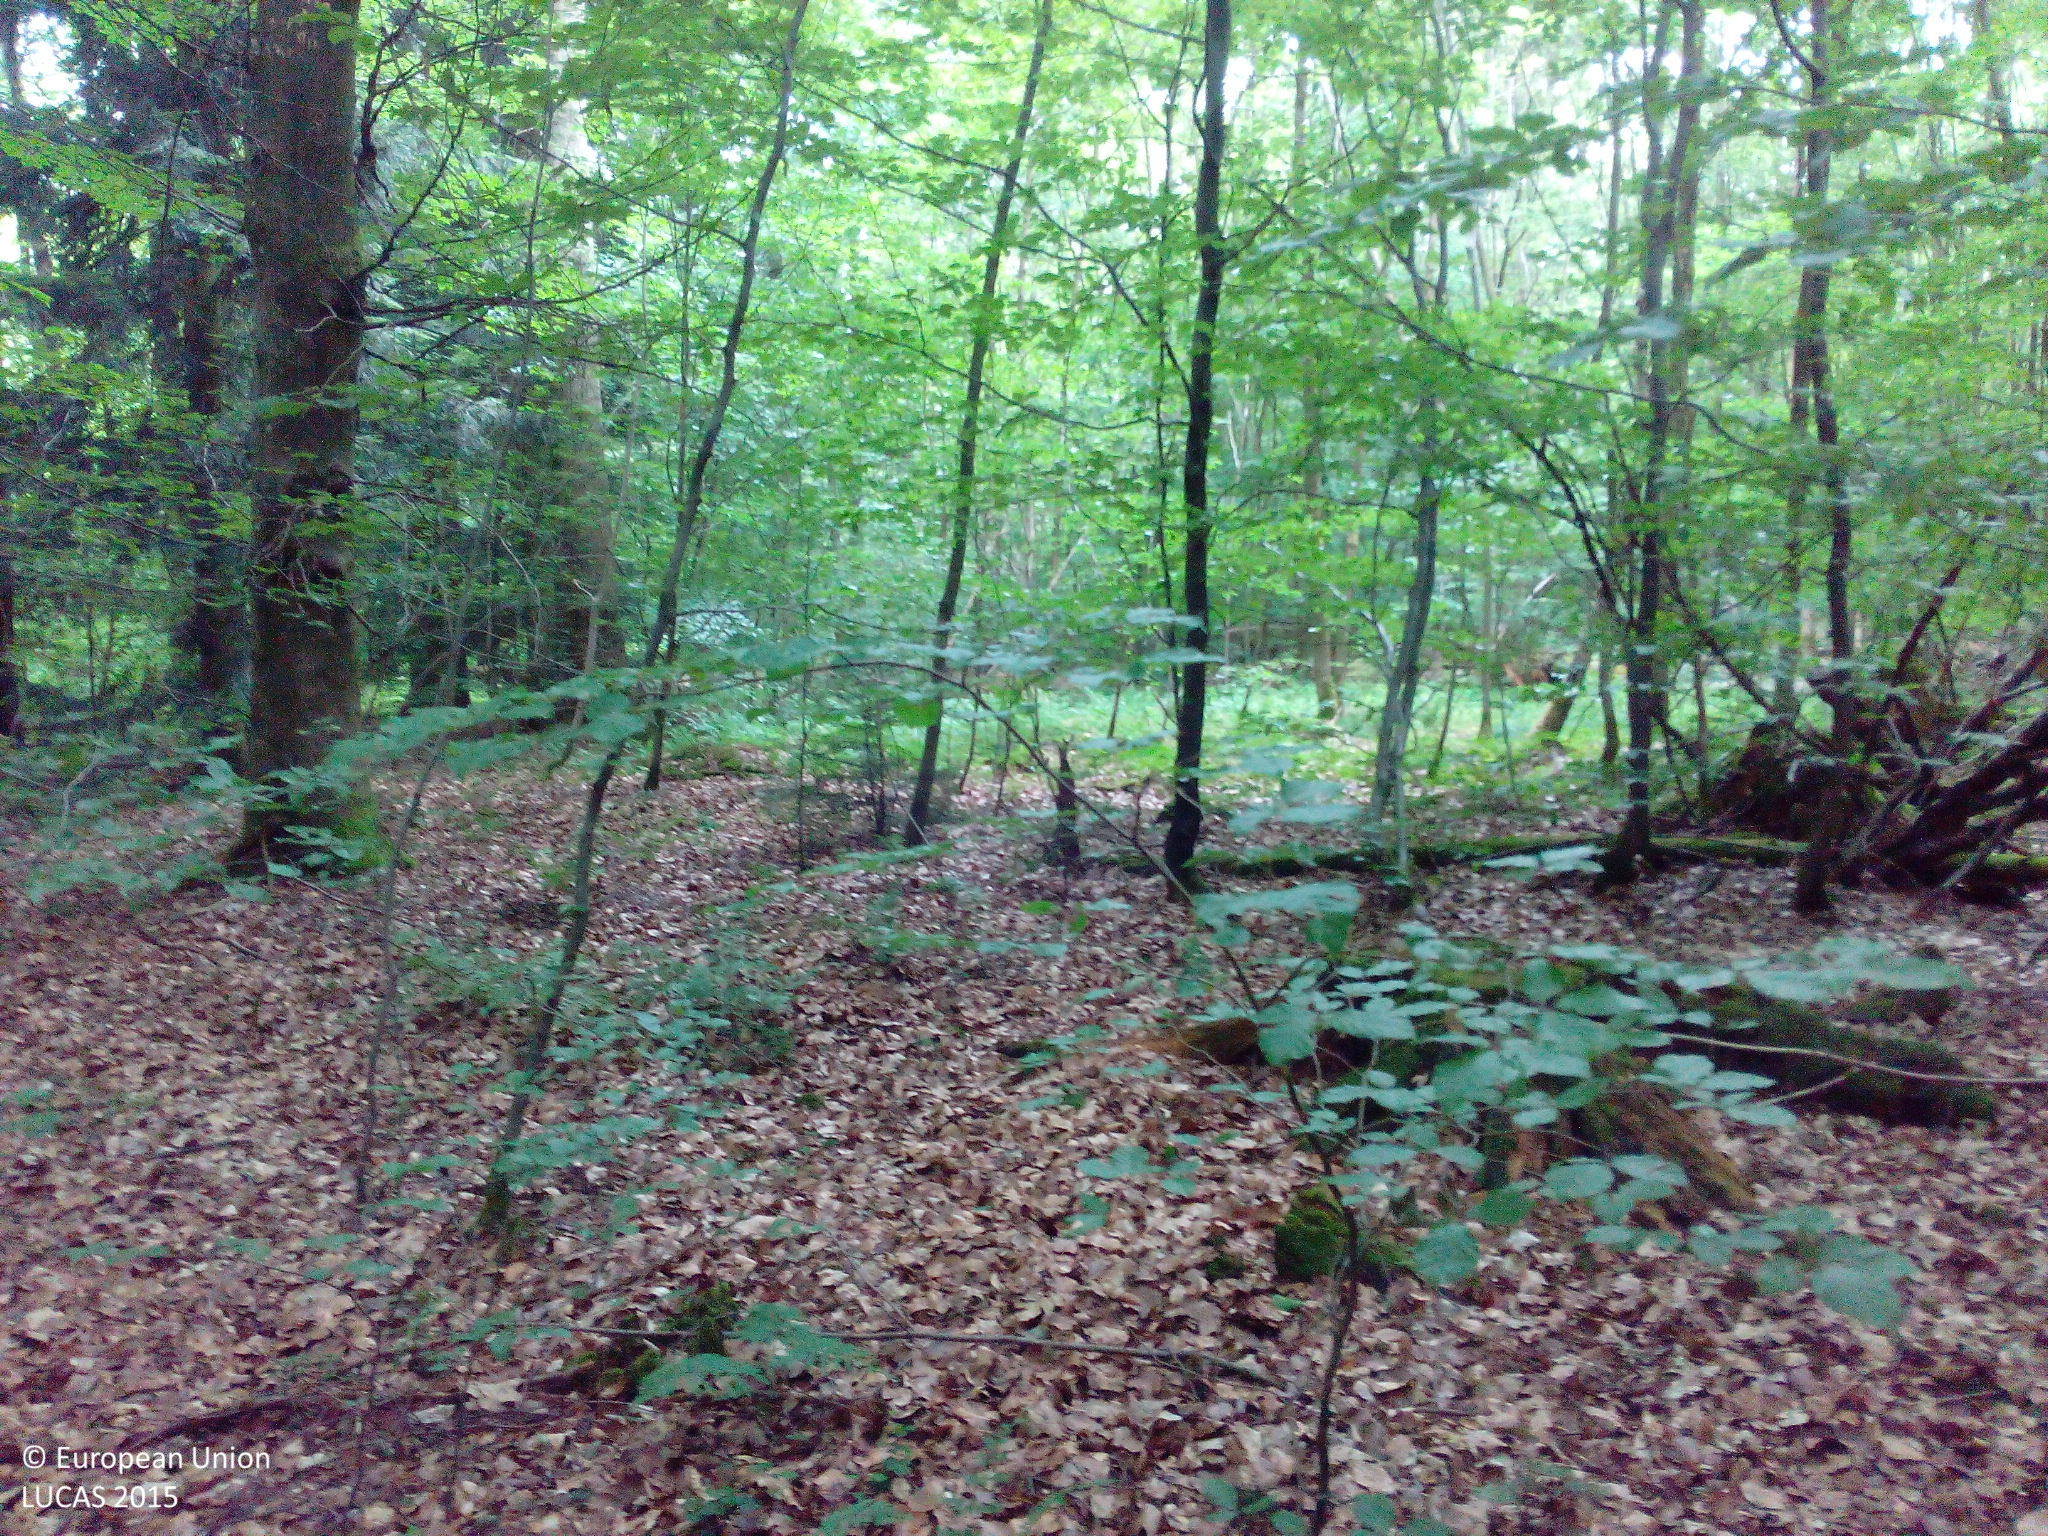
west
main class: Woodland
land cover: Spruce dominated mixed woodland
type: hemiboreal forest and nemoral coniferous forest and mixed broadleaved-coniferous forest
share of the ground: > 75 %
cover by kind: broadleaved forest trees 70 %, coniferous forest trees 25 %, unconsolidated bare surface 5 %
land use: Forestry
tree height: > 5 m
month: June
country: DE
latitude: 49.2835
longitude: 9.4091
